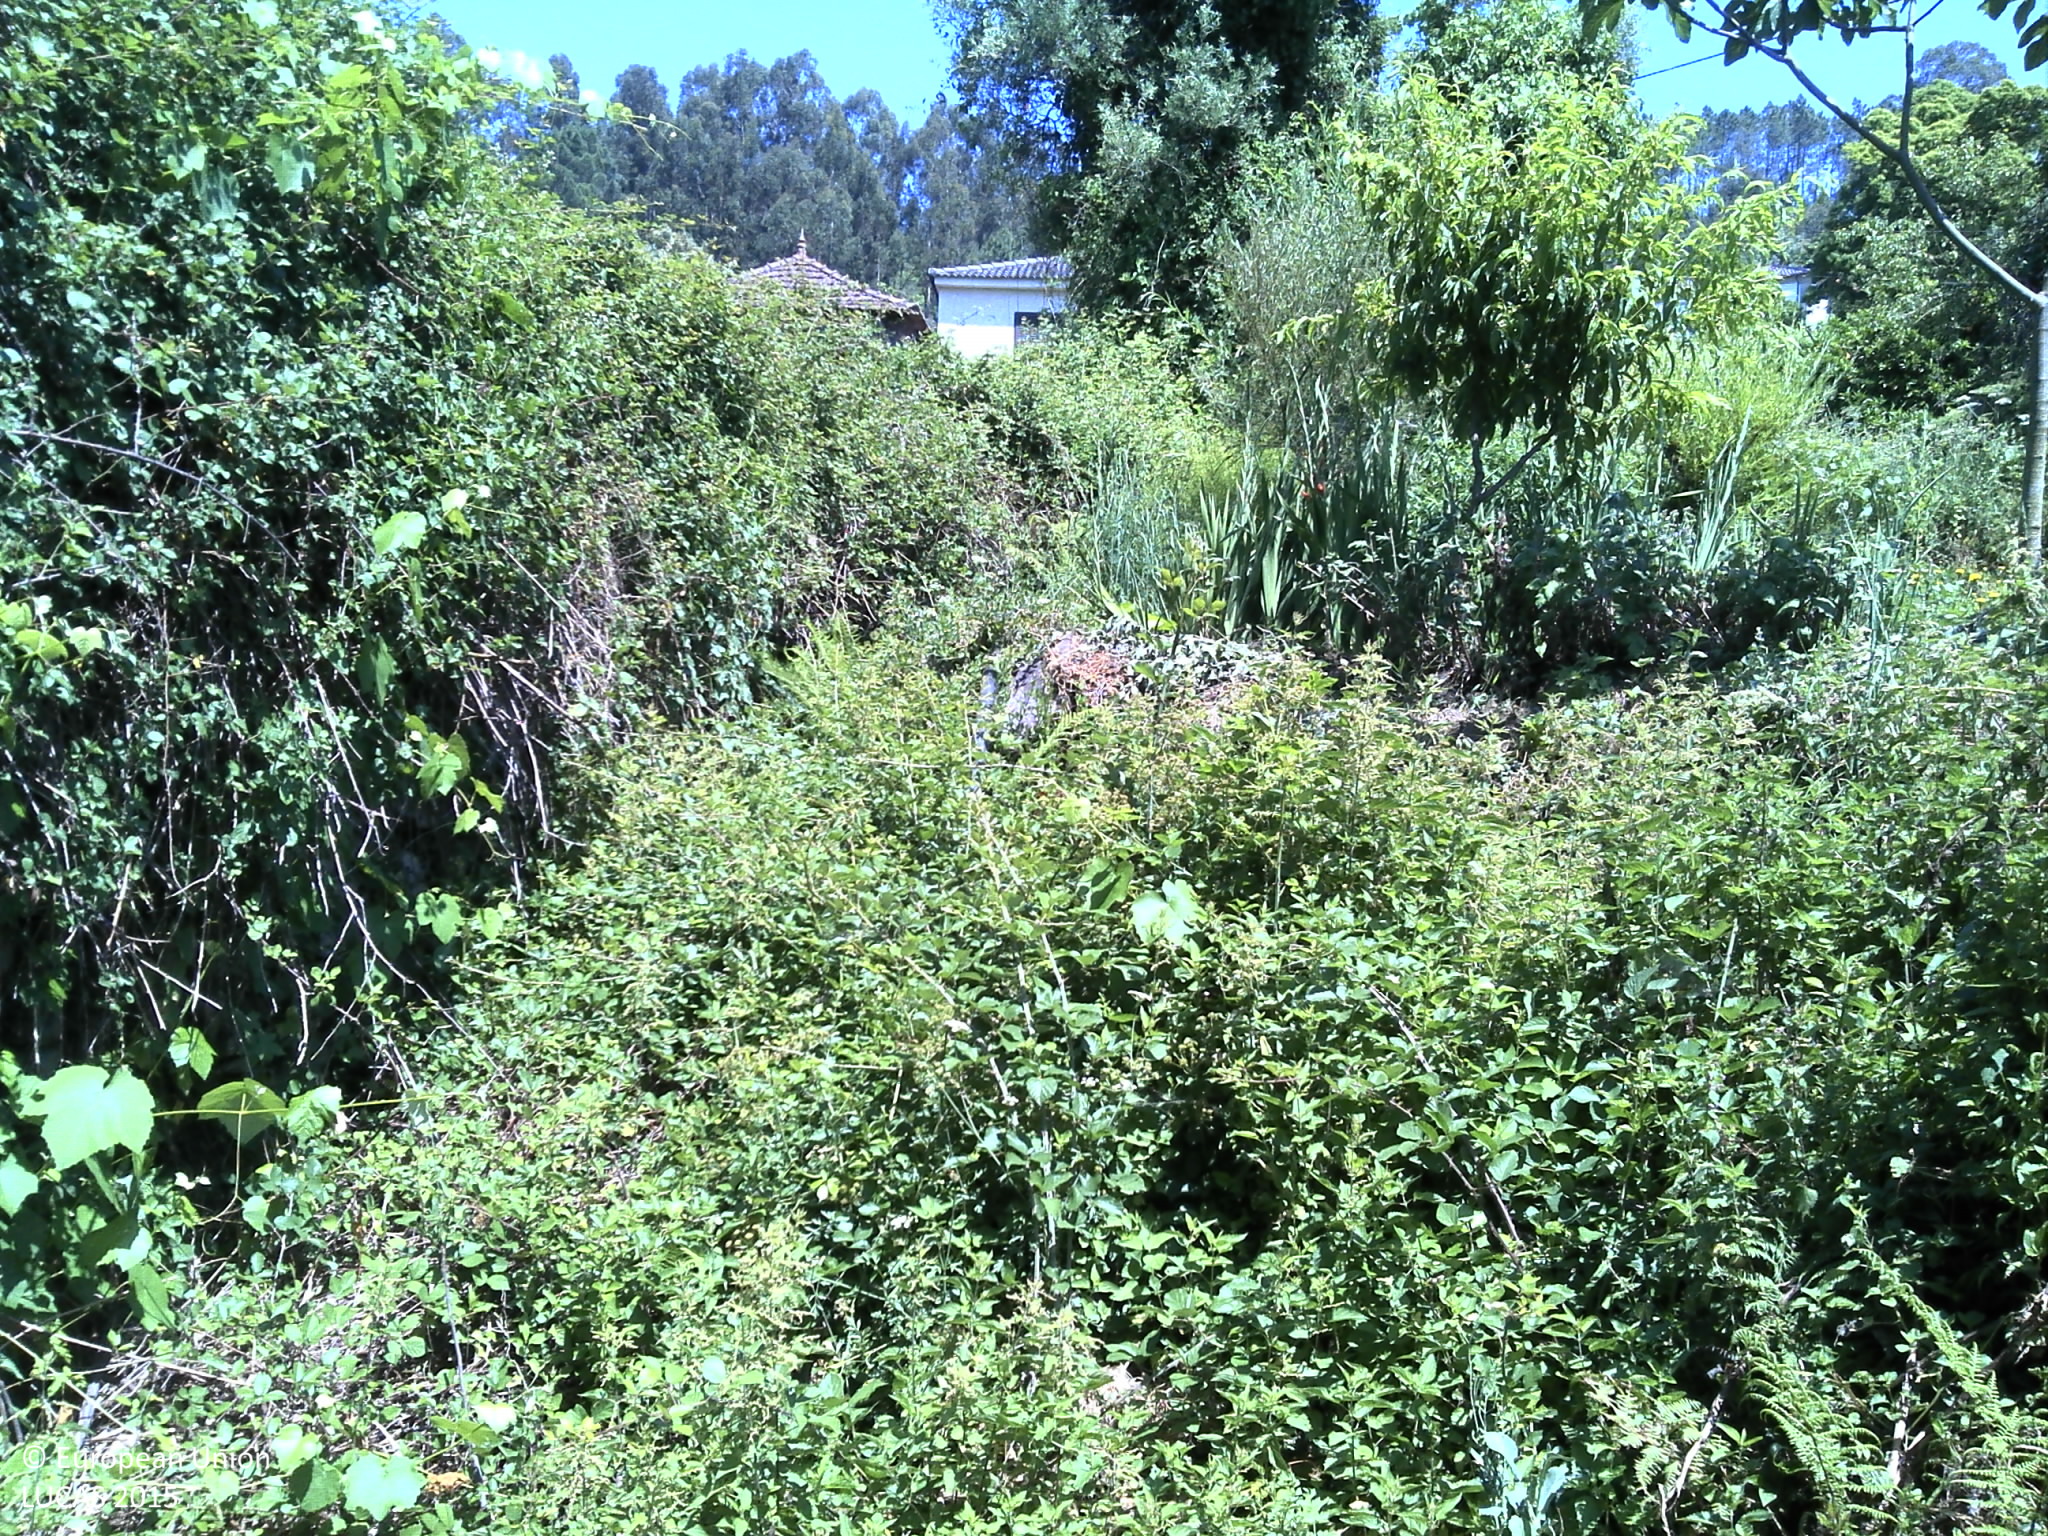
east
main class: Shrubland
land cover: Shrubland without tree cover
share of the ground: 50 - 75 %
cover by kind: shrubs 50 %, herbaceous plants 40 %, consolidated bare surface 10 %
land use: Abandoned areas
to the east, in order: Shrubland without tree cover; Other fruit trees and berries; Grassland without tree/shrub cover; Electric lines; Grassland without tree/shrub cover; Artificial constructions in urban areas; Vineyards; Other fresh vegetables; Vineyards; Grassland without tree/shrub cover; Dry stone walls; Temporary grasslands; Artificial constructions in urban areas; Shrubland without tree cover; Electric lines; Shrubland without tree cover; Electric lines; Shrubland without tree cover; Vineyards; Artificial constructions in urban areas; Broadleaved woodland
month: June
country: PT
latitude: 41.9903
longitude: -8.4741
